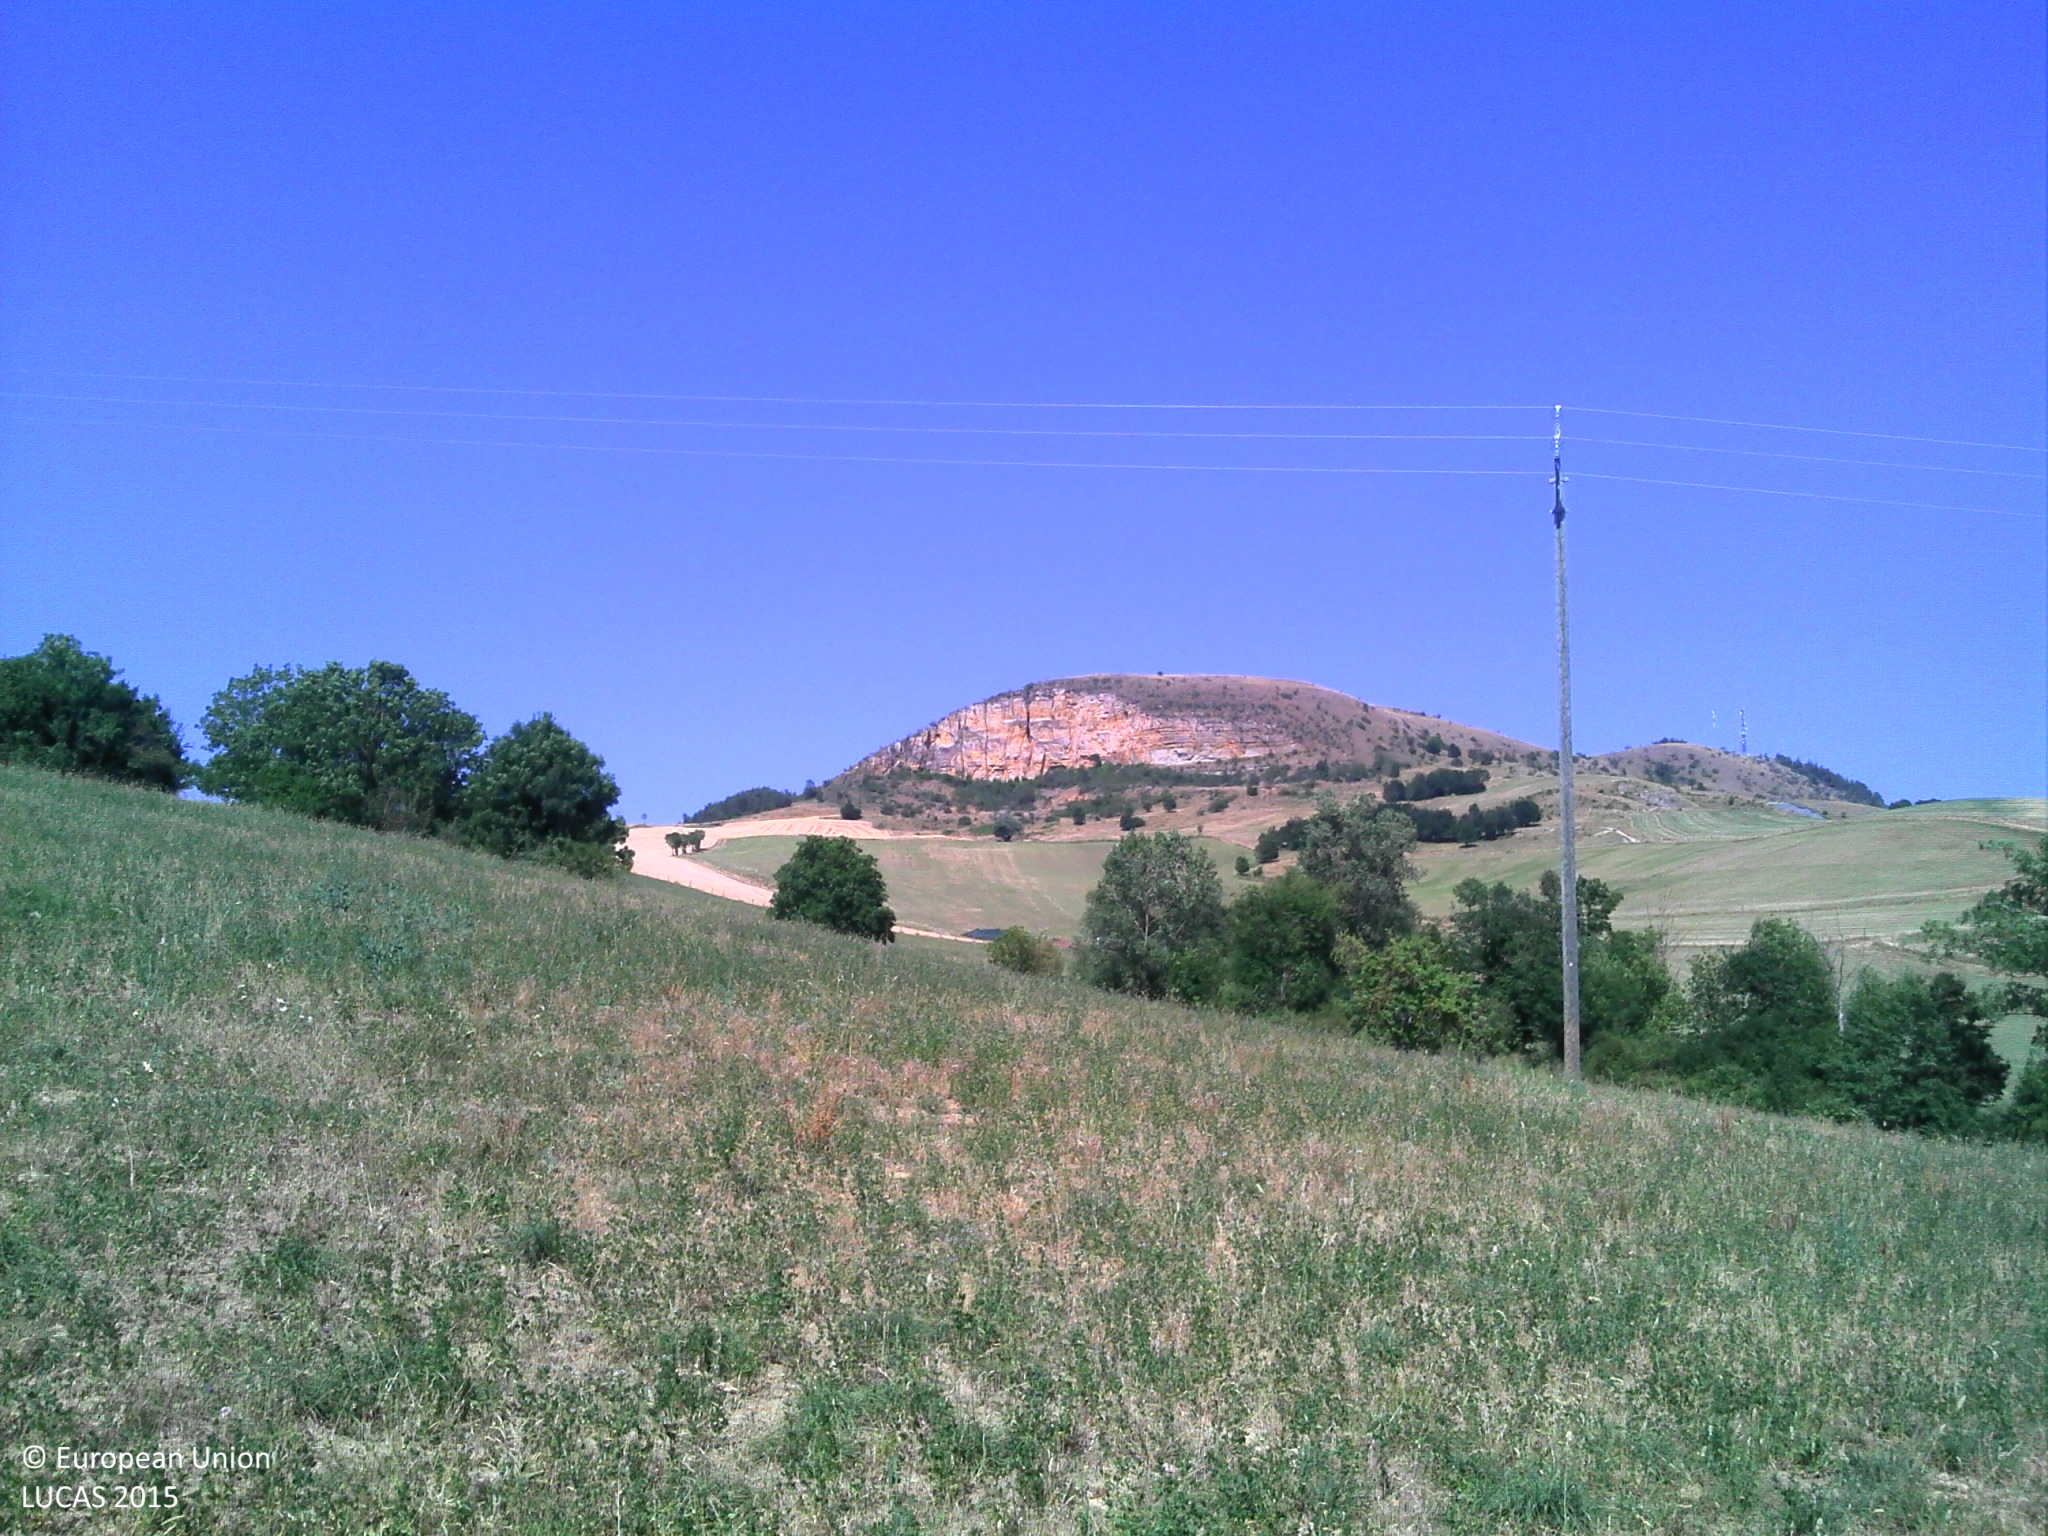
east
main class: Cropland
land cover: Temporary grasslands
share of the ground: > 75 %
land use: Agriculture (excluding fallow land and kitchen gardens)
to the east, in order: Temporary grasslands; Electric lines; Temporary grasslands; Tracks; Grassland without tree/shrub cover; Fences; Lines of trees; Rivers and streams; Lines of trees; Temporary grasslands; Fences; Single bushes/trees; Temporary grasslands
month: July
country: FR
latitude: 44.5318
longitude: 3.2975
